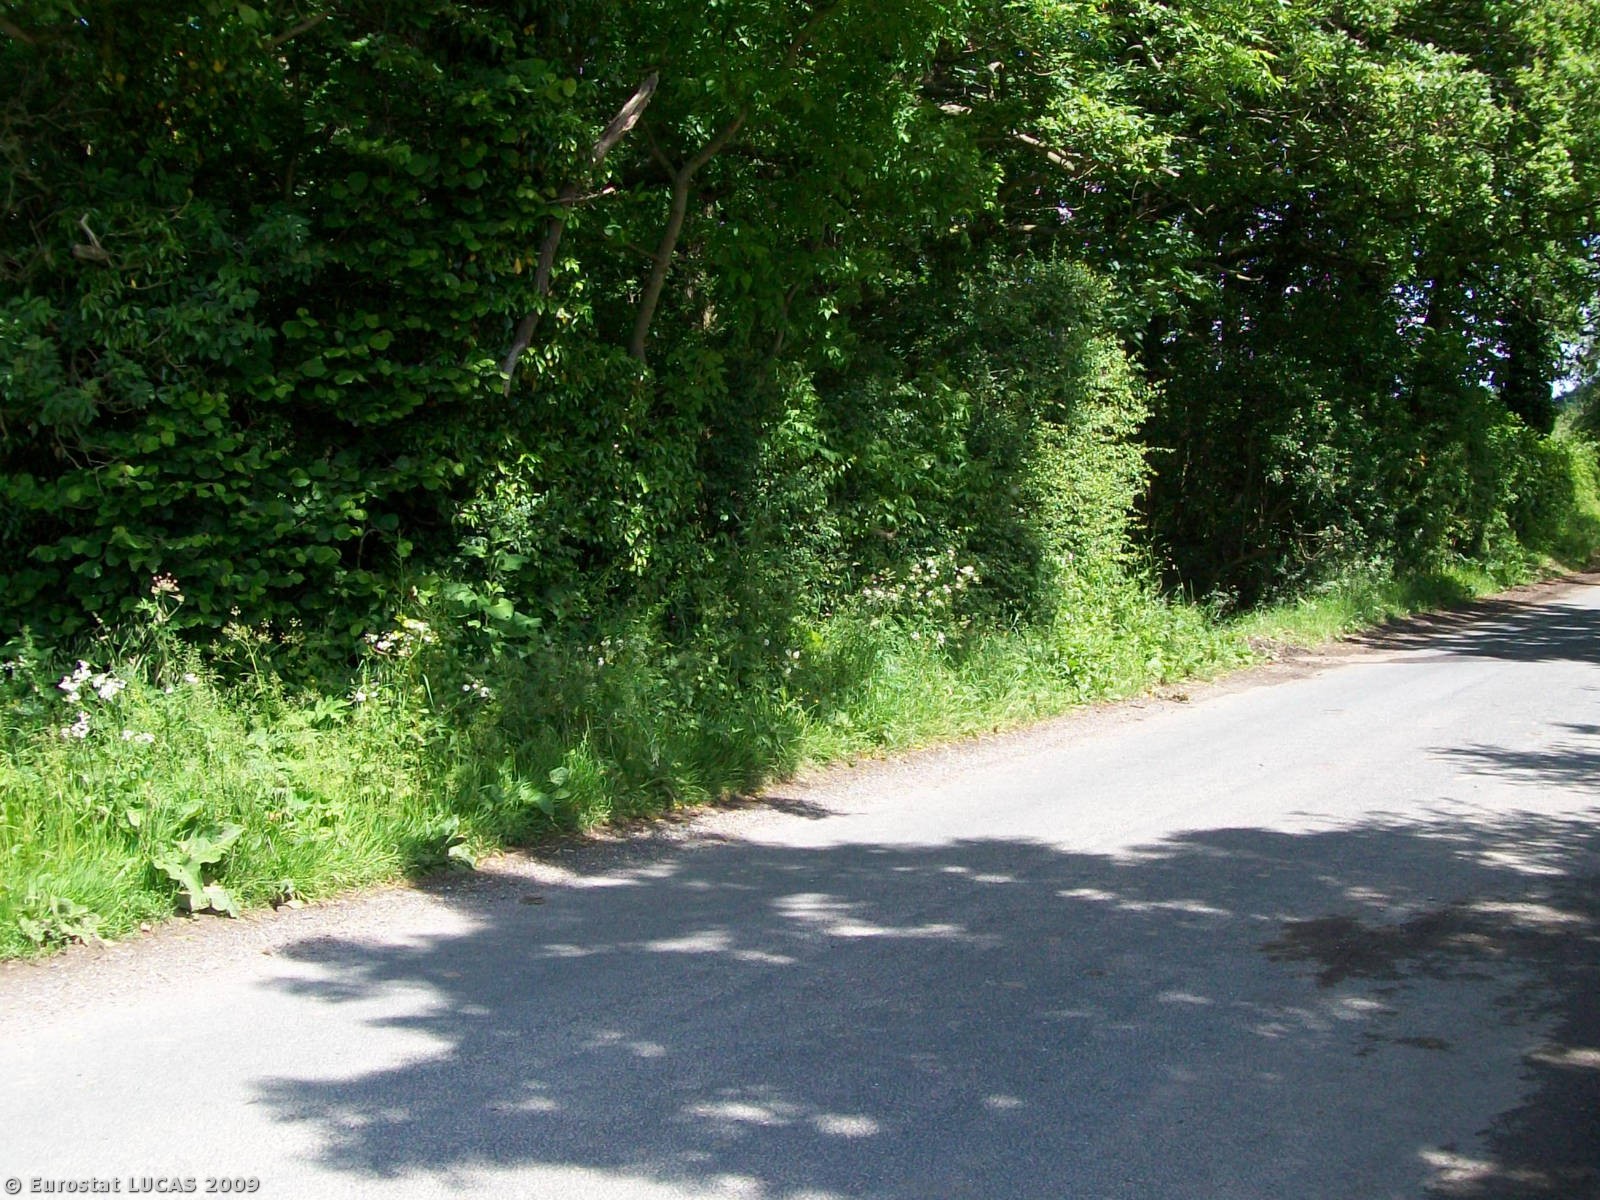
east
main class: Cropland
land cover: Common wheat
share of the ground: < 10 %
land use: Agriculture (excluding fallow land and kitchen gardens)
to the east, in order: Common wheat; Broadleaved woodland; Grass margins; Paved roads, cycling and walking lanes; Grass margins; Managed hedges; Fences; Grassland without tree/shrub cover
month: June
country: GB
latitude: 54.4565
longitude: -1.6346
